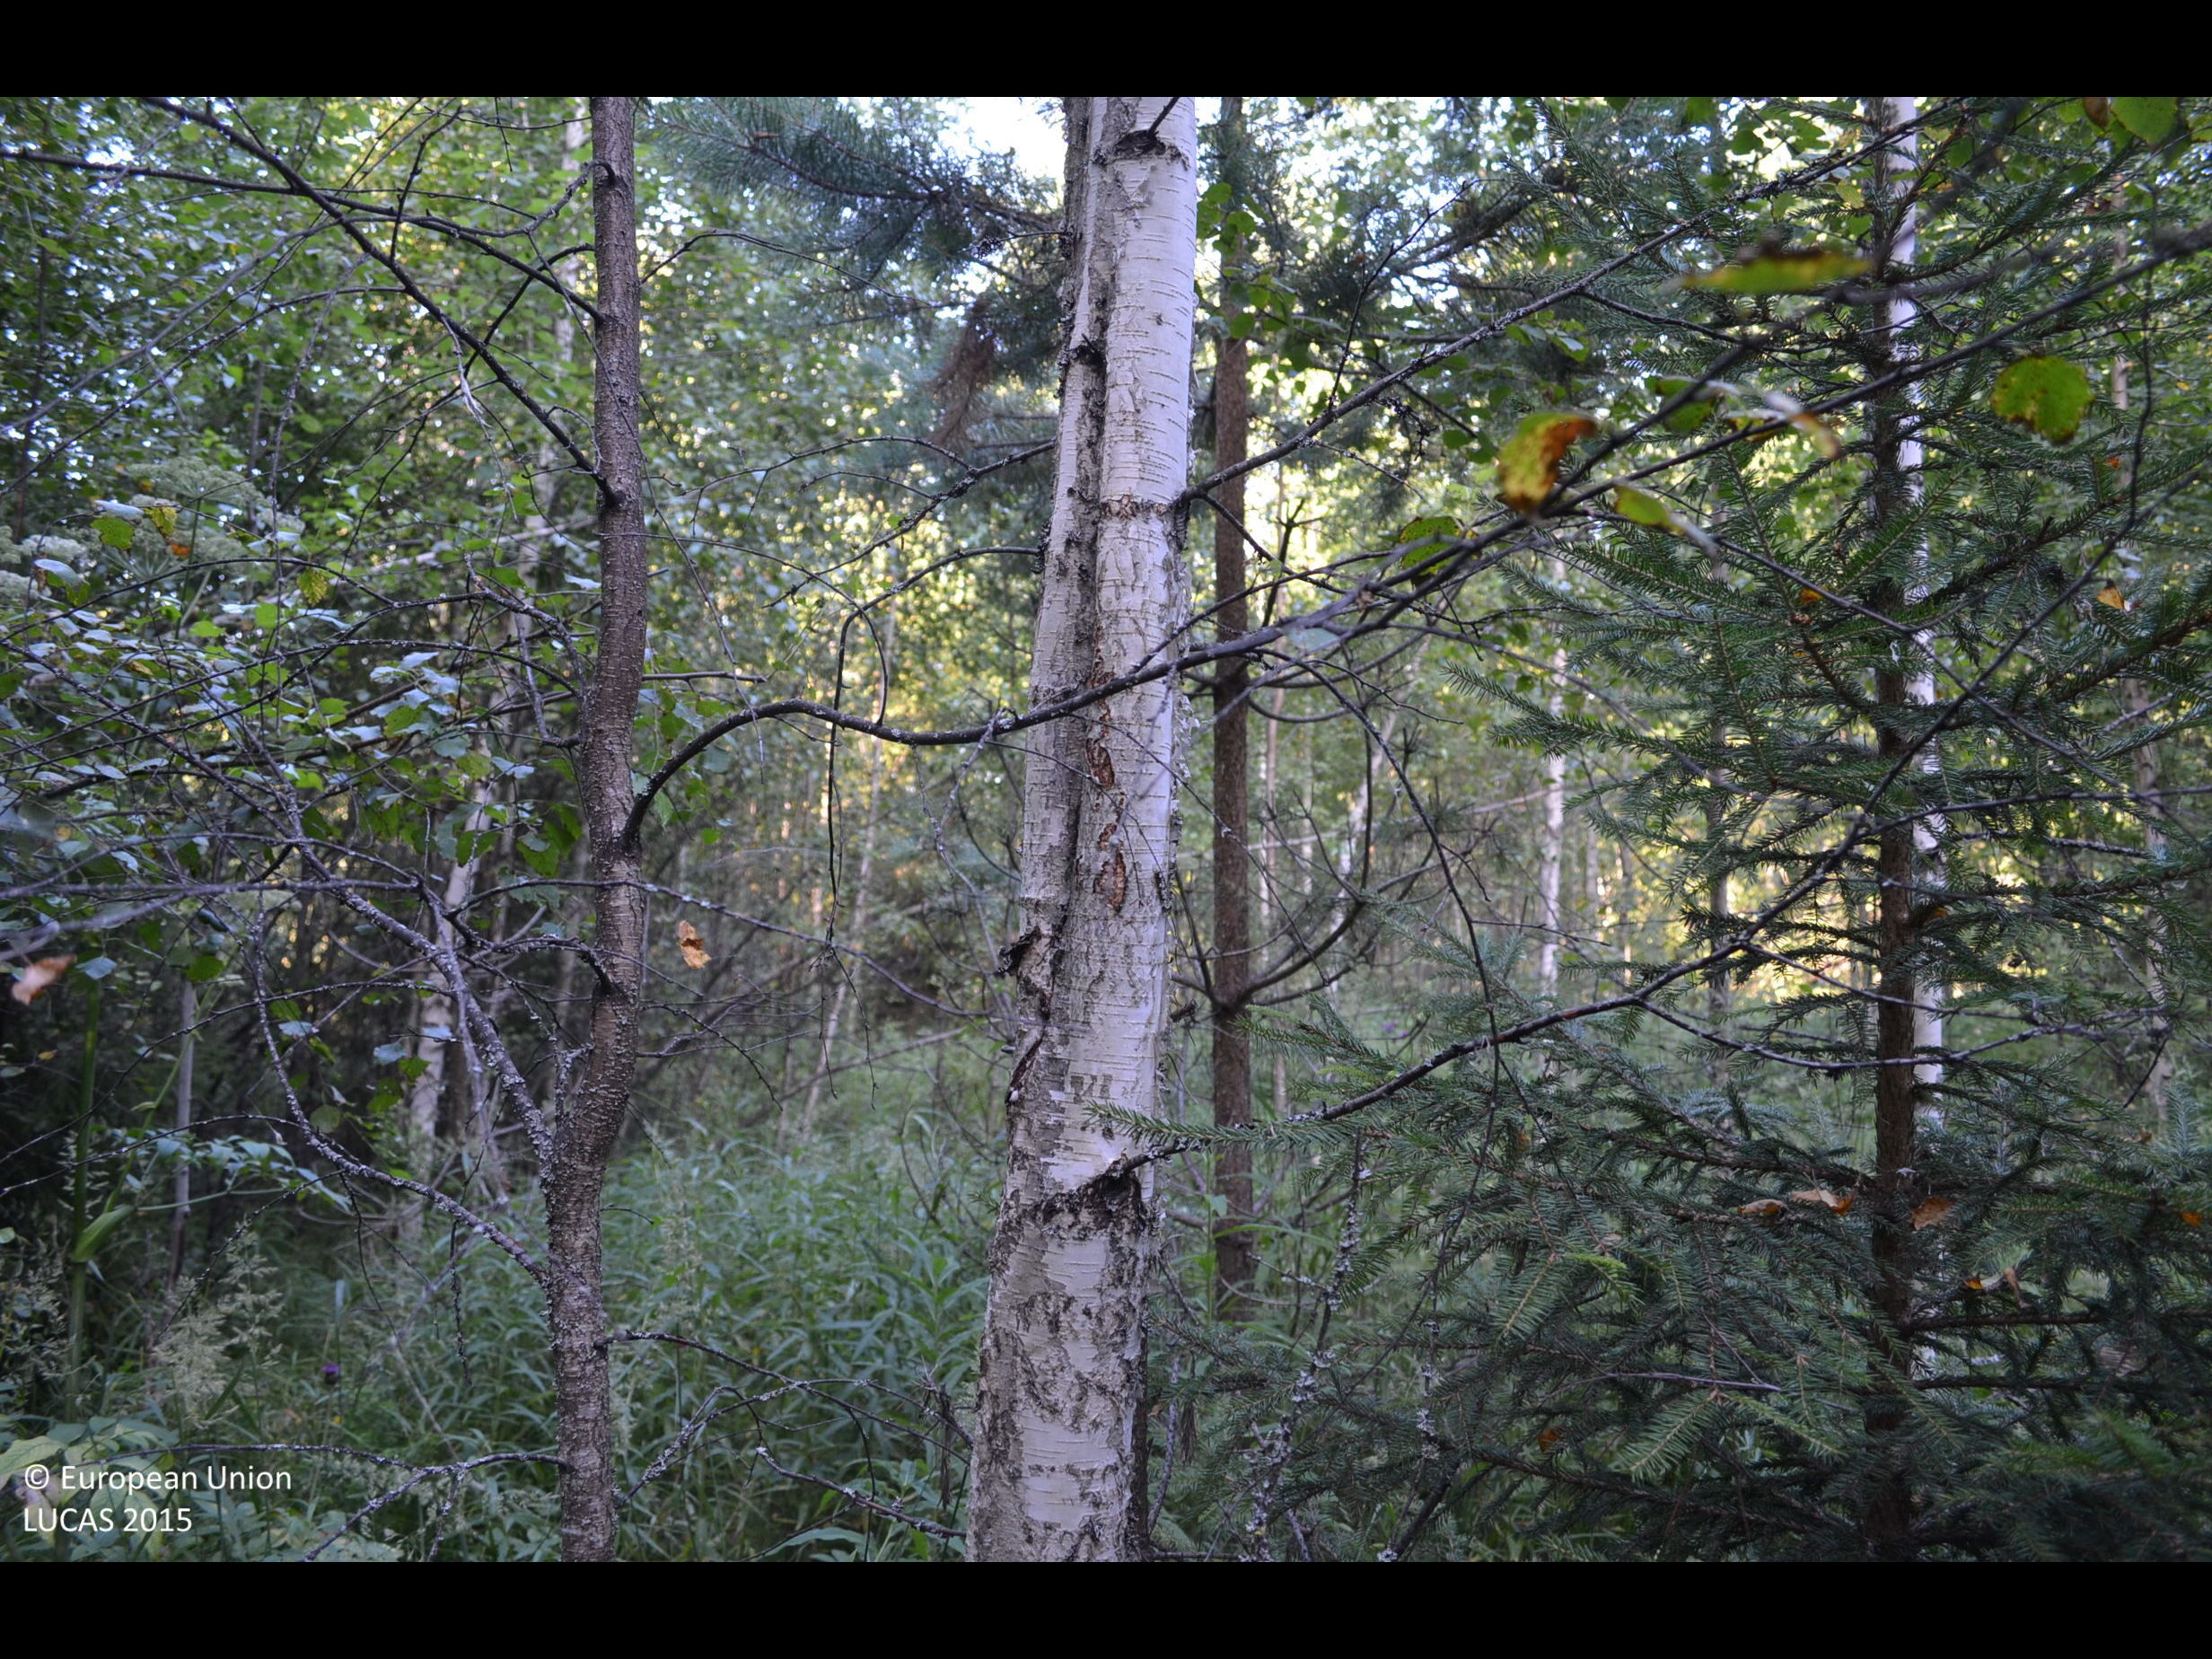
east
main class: Woodland
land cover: Broadleaved woodland
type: boreal forest
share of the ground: > 75 %
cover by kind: broadleaved forest trees 65 %, herbaceous plants 20 %, coniferous forest trees 15 %
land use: Forestry
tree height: > 5 m
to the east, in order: Broadleaved woodland; Ditches and canals; Broadleaved woodland; Groves; Ditches and canals; Grassland with sparse tree/shrub cover; Ditches and canals; Oats; Grassland without tree/shrub cover; Abandoned hedges; Inland fresh water bodies
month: August
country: FI
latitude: 62.0922
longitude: 24.2804
